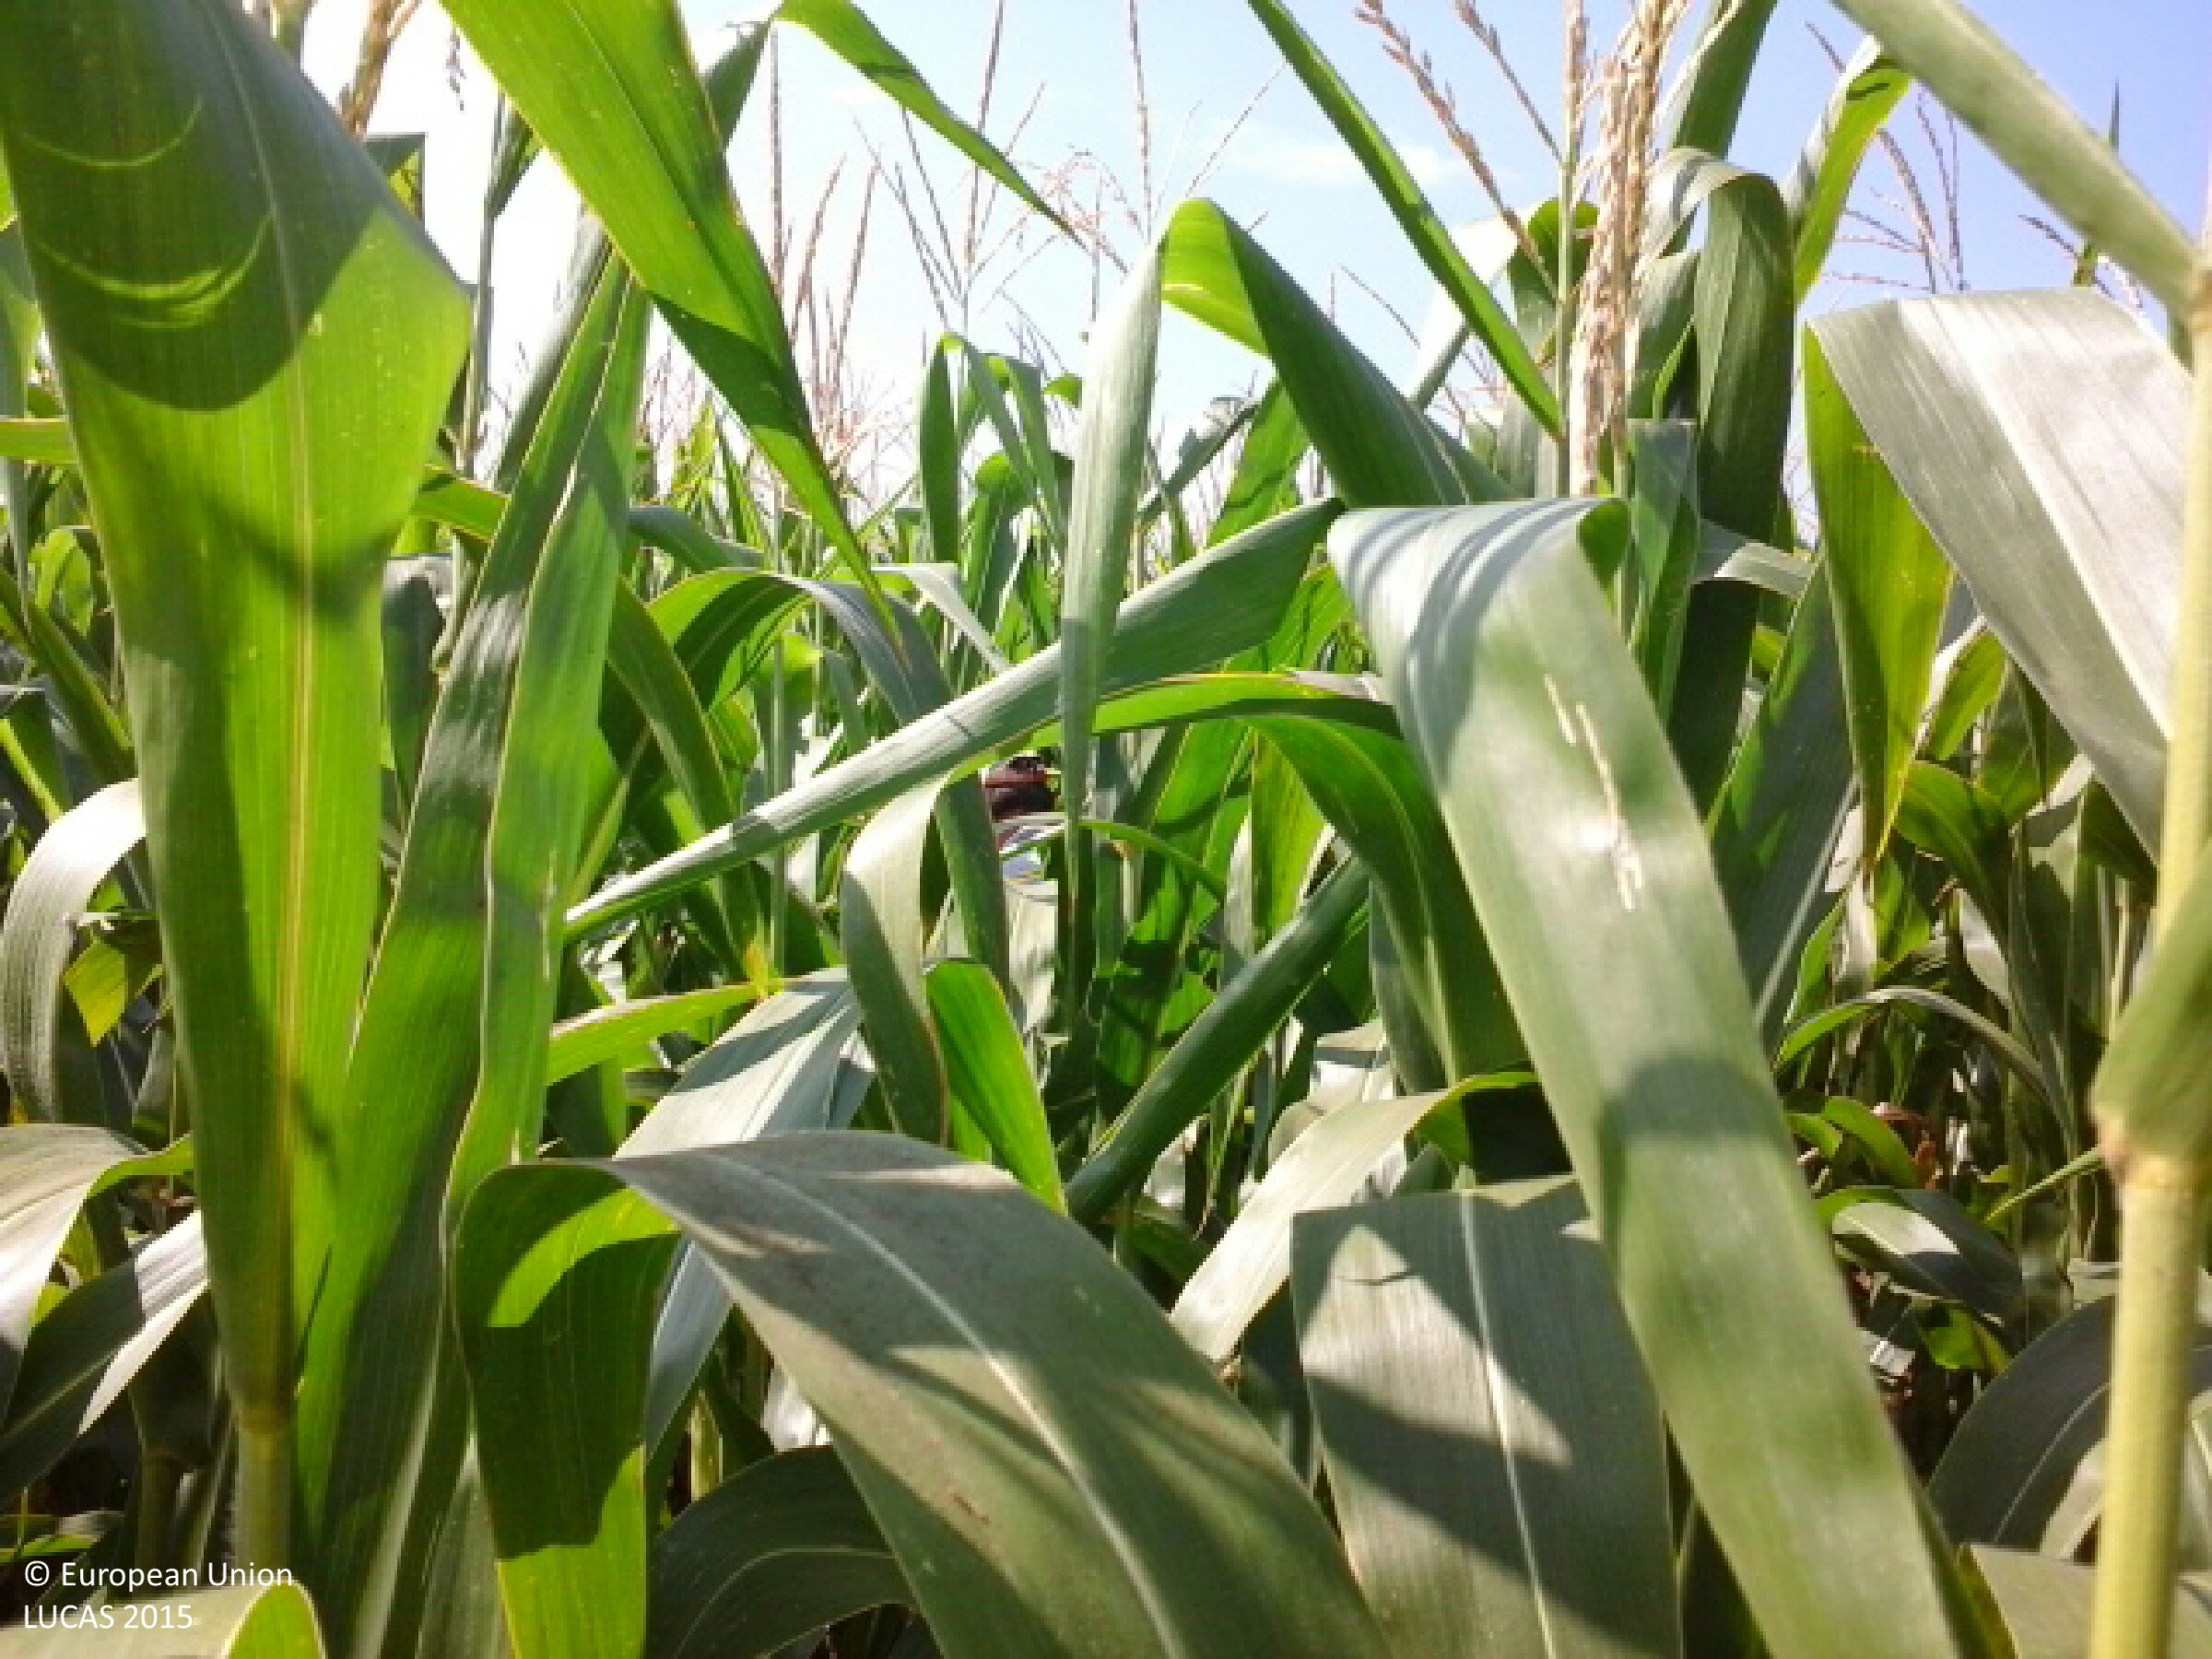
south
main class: Cropland
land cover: Maize
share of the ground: > 75 %
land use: Agriculture (excluding fallow land and kitchen gardens)
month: August
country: HU
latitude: 47.6022
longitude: 18.5404
